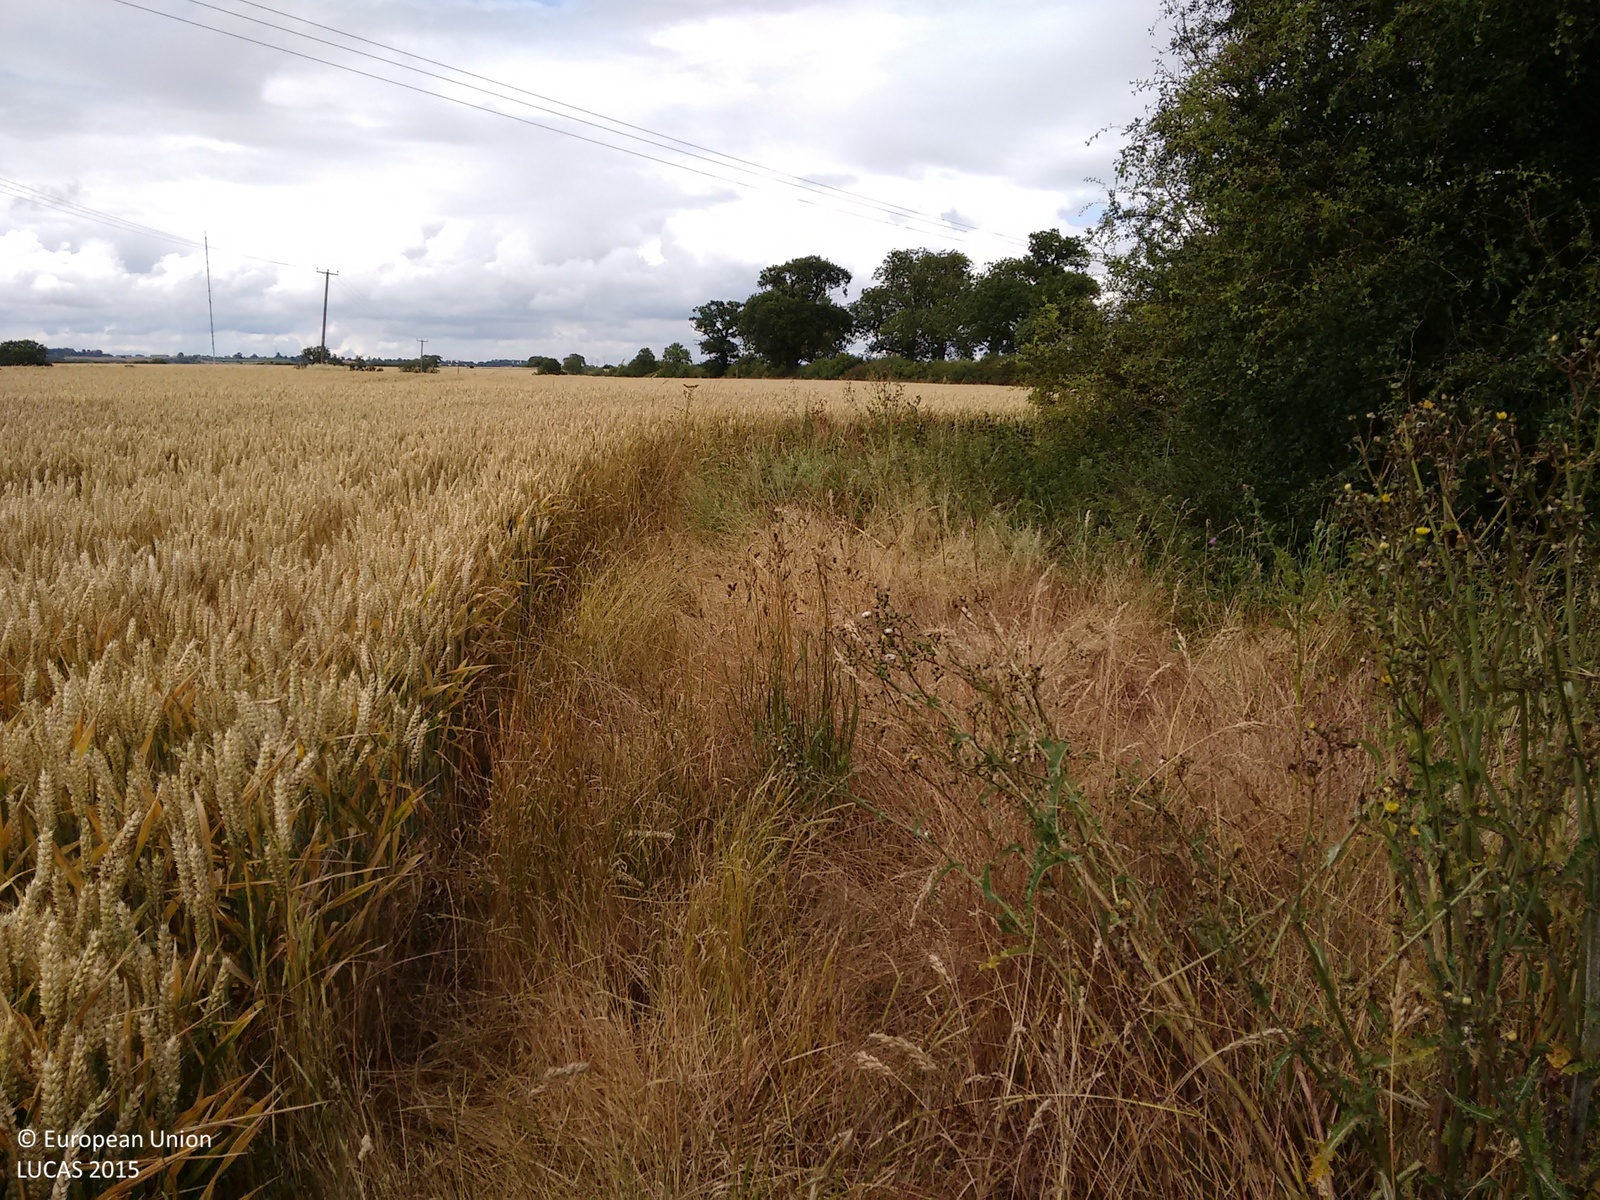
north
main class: Cropland
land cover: Common wheat
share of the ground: > 75 %
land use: Agriculture (excluding fallow land and kitchen gardens)
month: July
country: GB
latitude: 52.7733
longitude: -0.7880
